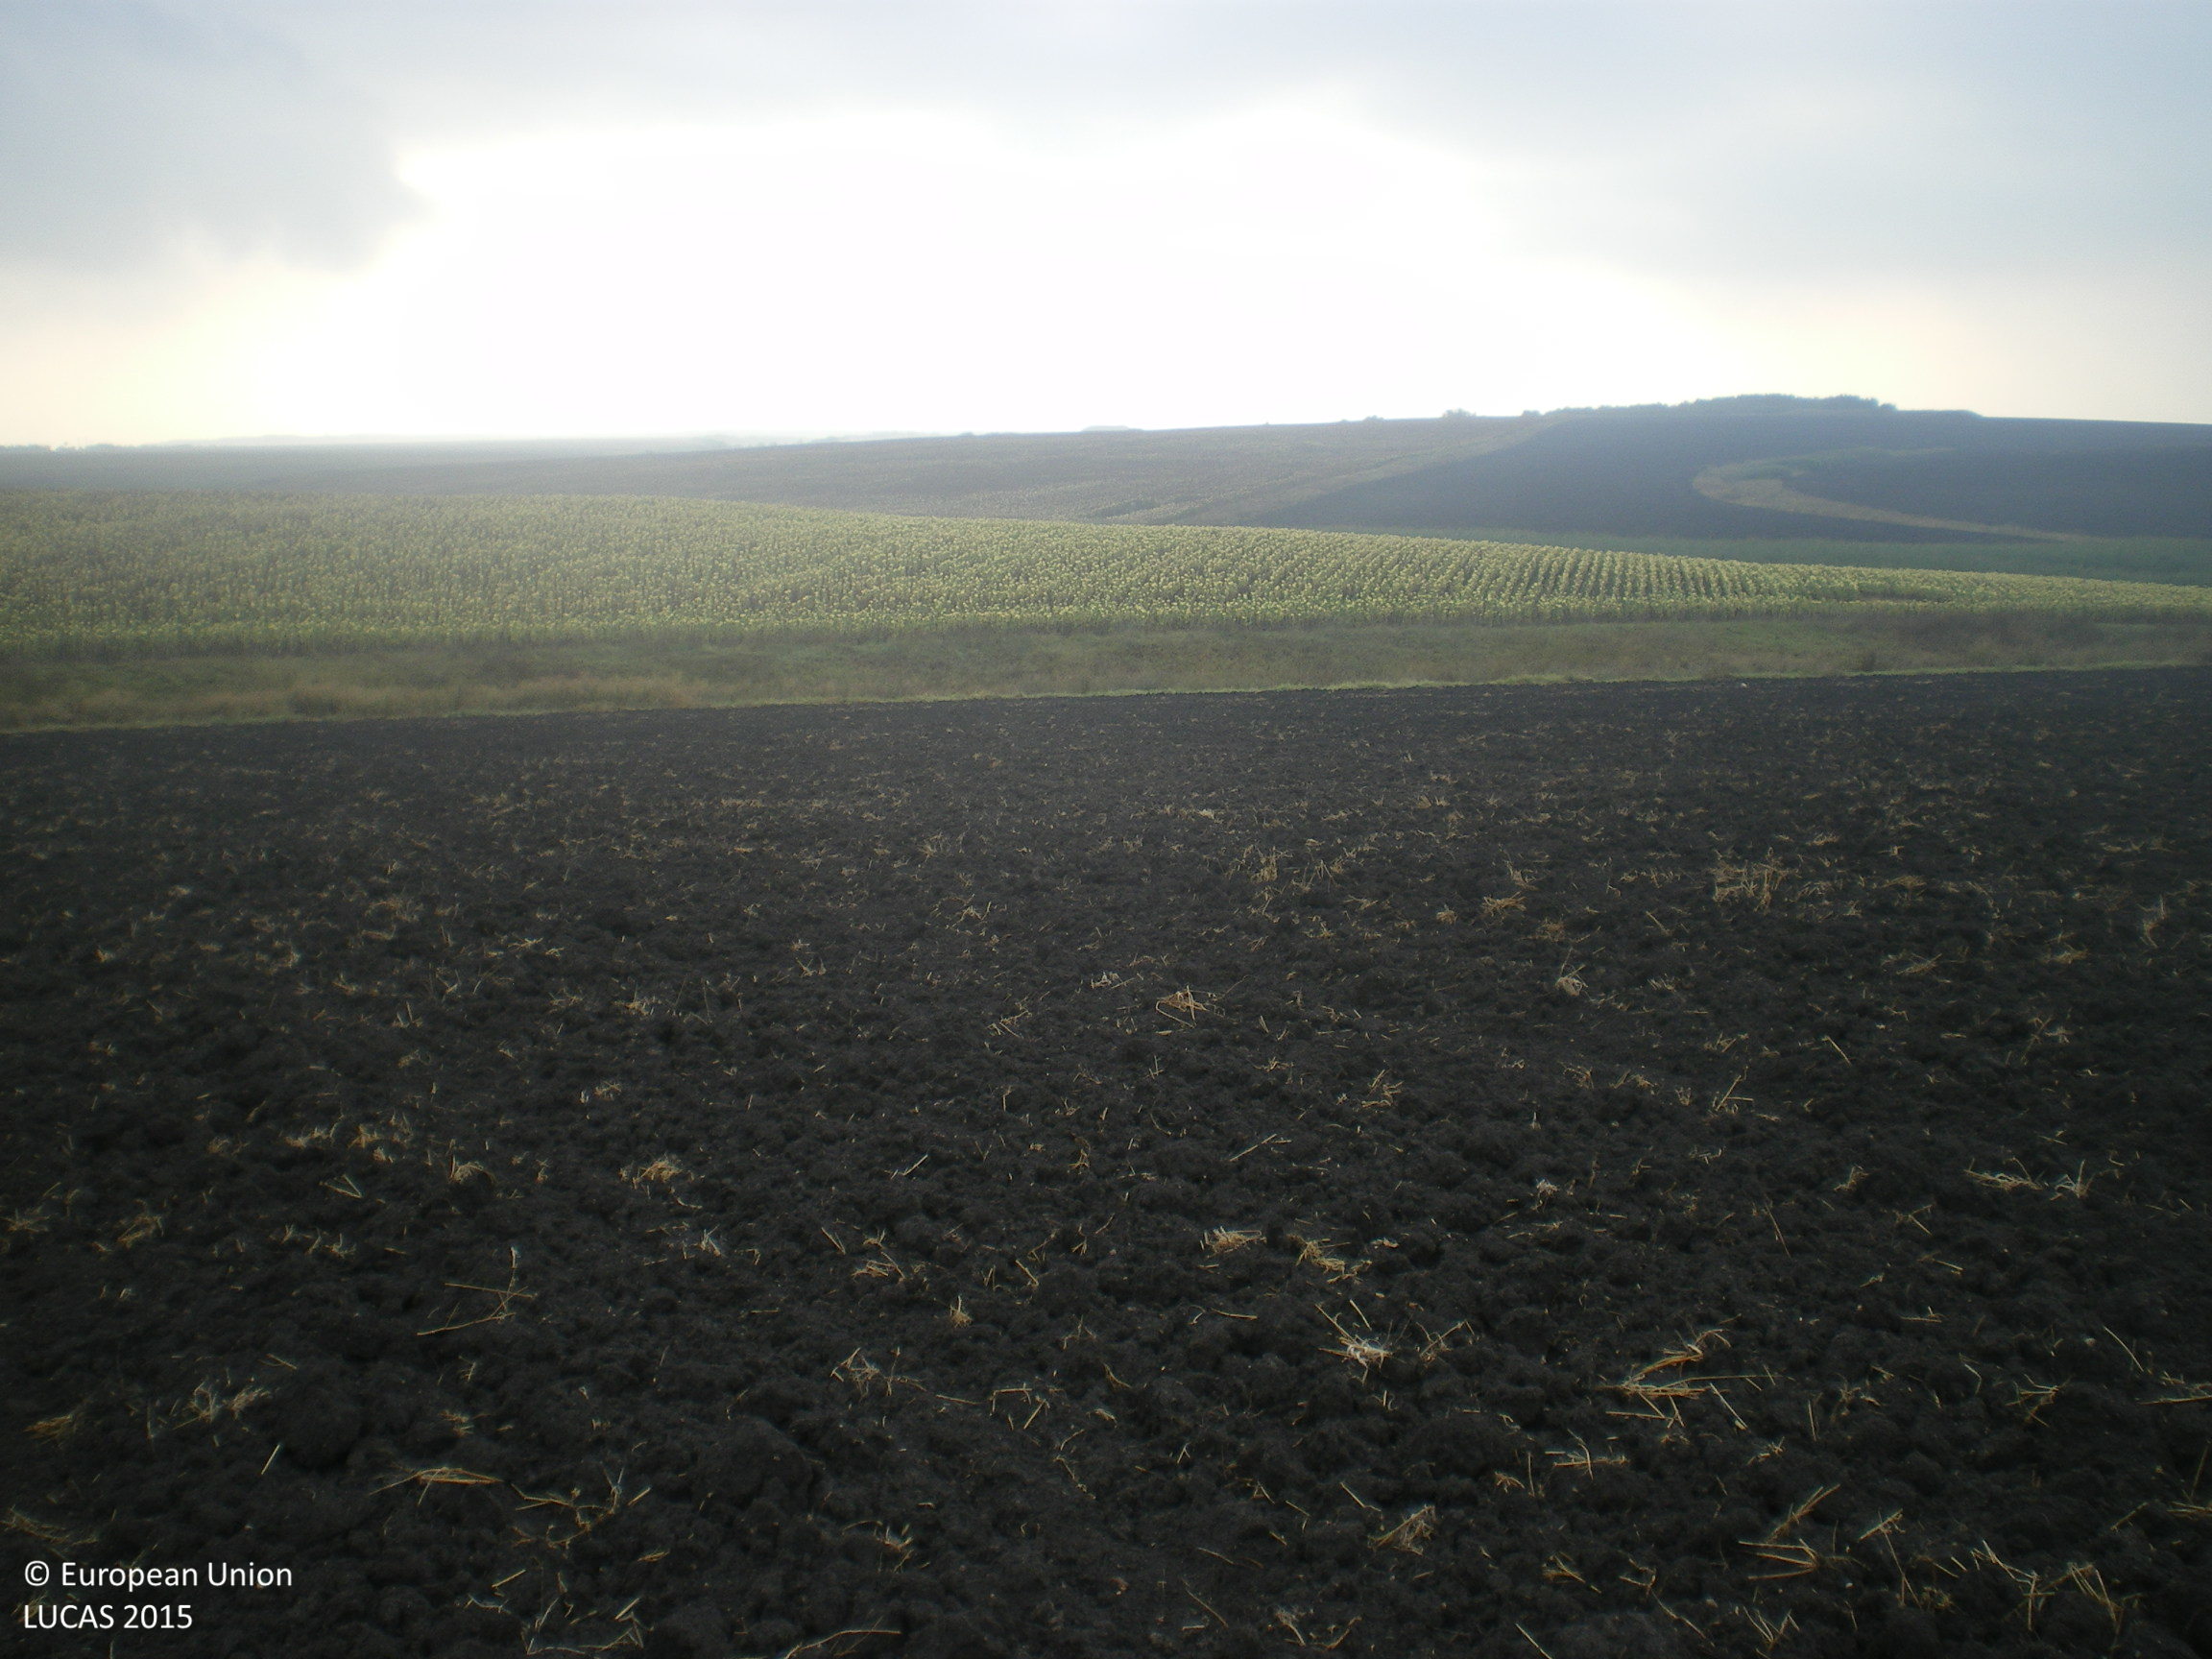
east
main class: Cropland
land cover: Common wheat
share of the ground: < 10 %
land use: Agriculture (excluding fallow land and kitchen gardens)
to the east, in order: Common wheat; Grassland without tree/shrub cover; Sunflower; Grassland without tree/shrub cover
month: August
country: BG
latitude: 42.2808
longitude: 25.9502
